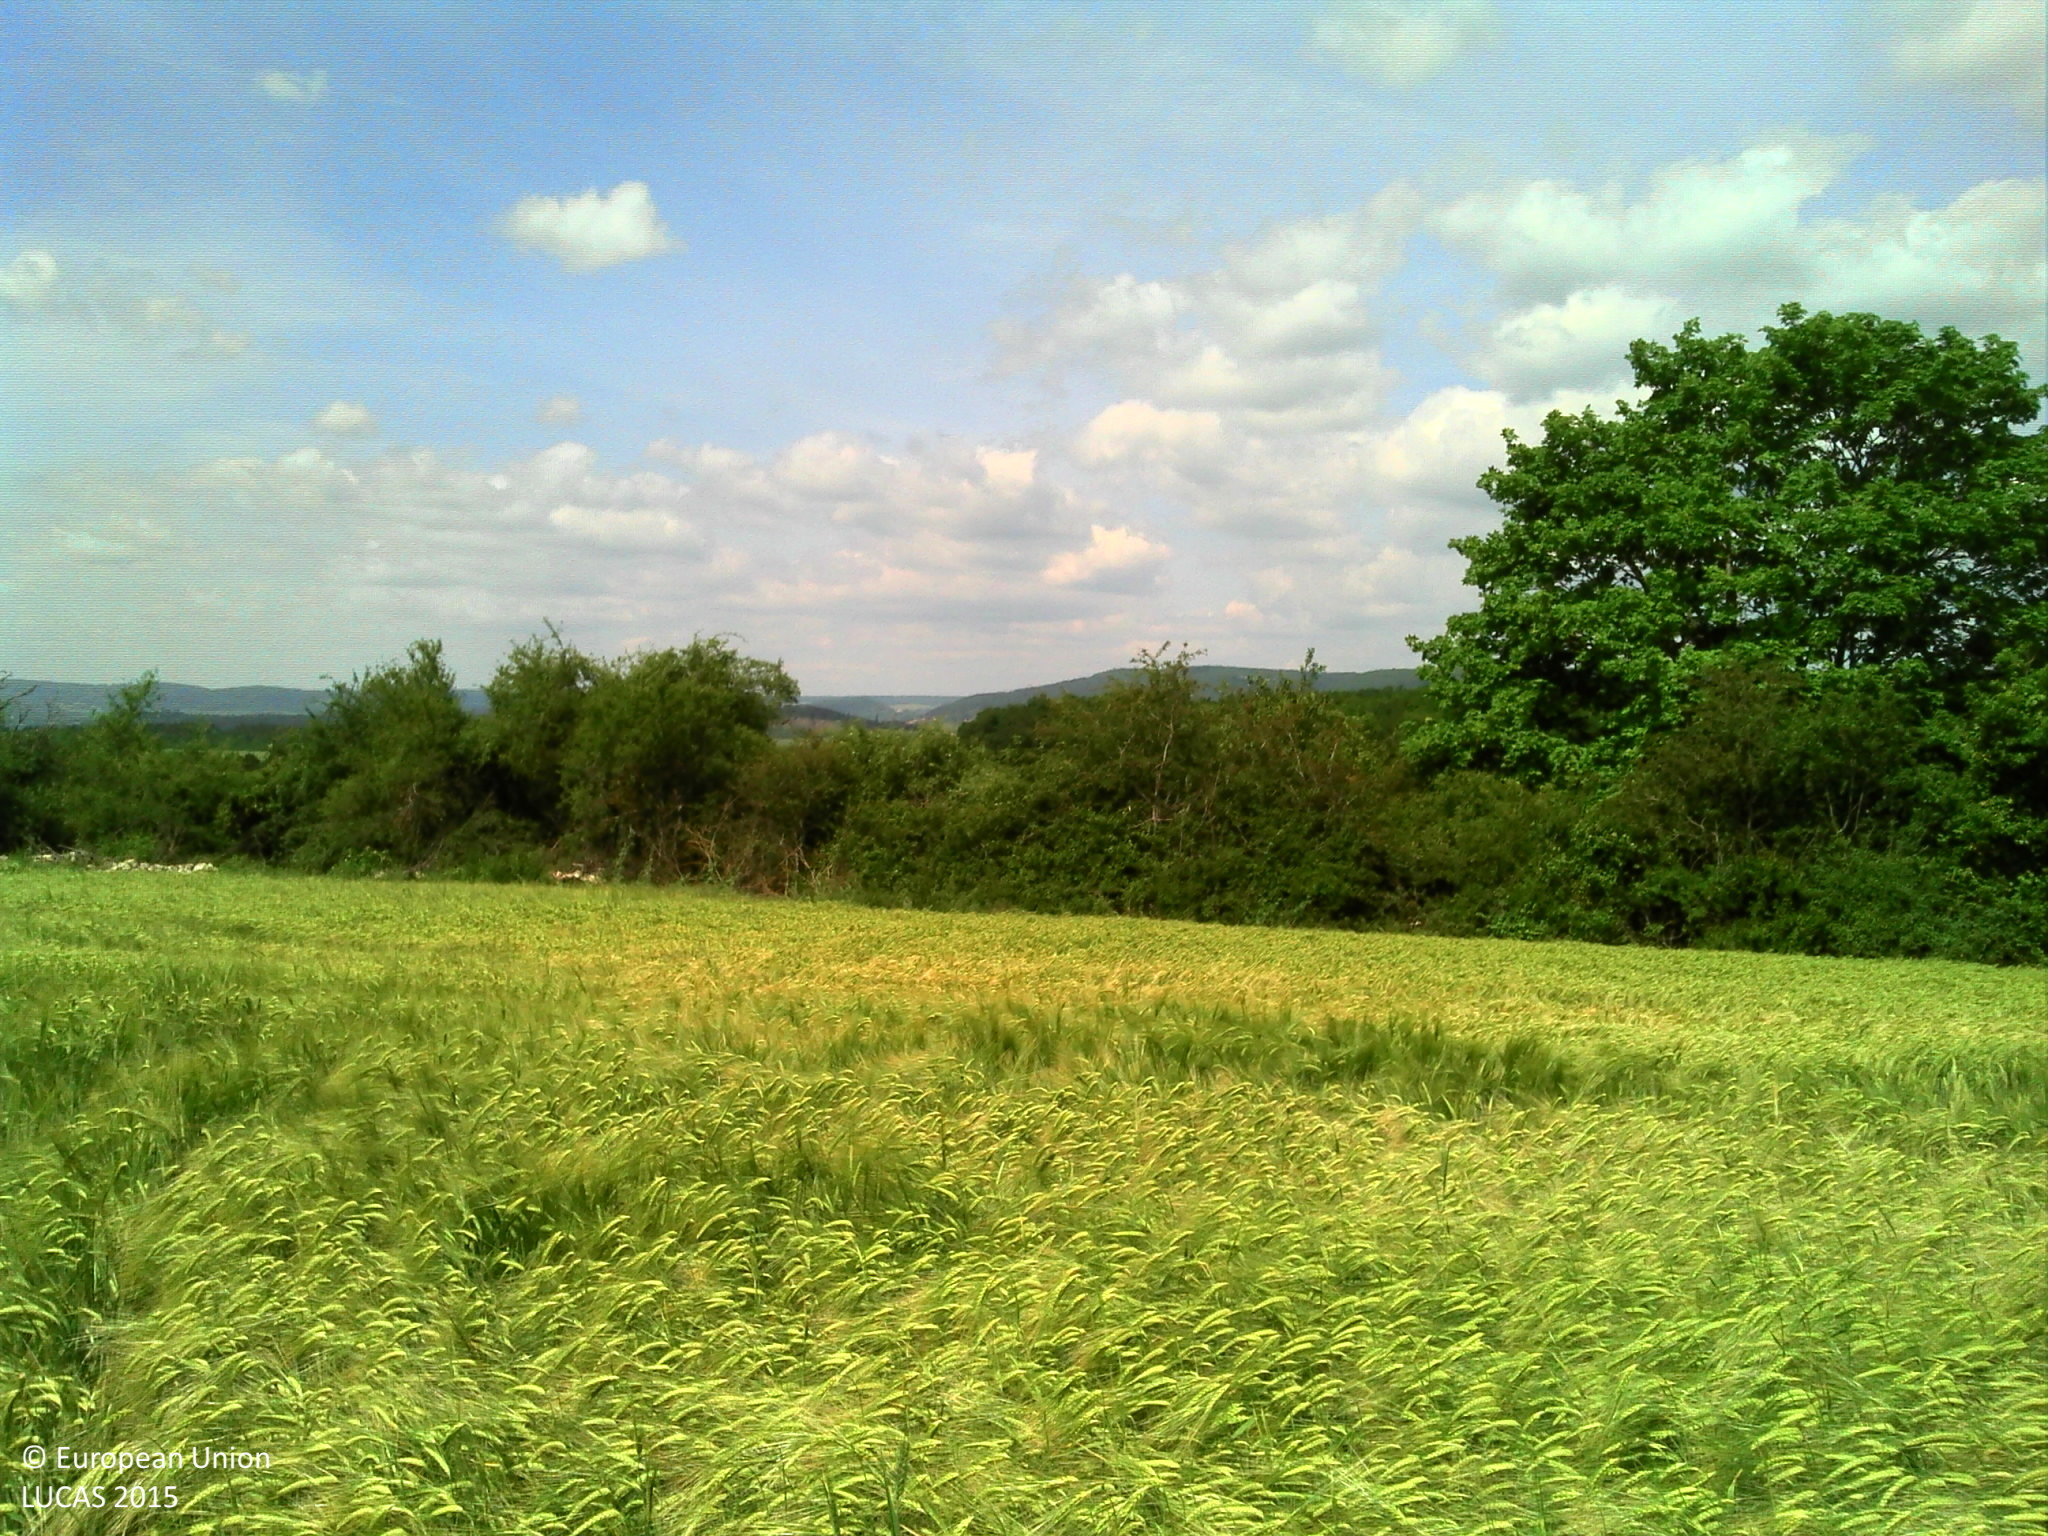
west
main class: Cropland
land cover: Barley
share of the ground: > 75 %
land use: Agriculture (excluding fallow land and kitchen gardens)
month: May
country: FR
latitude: 47.3304
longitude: 4.9056
